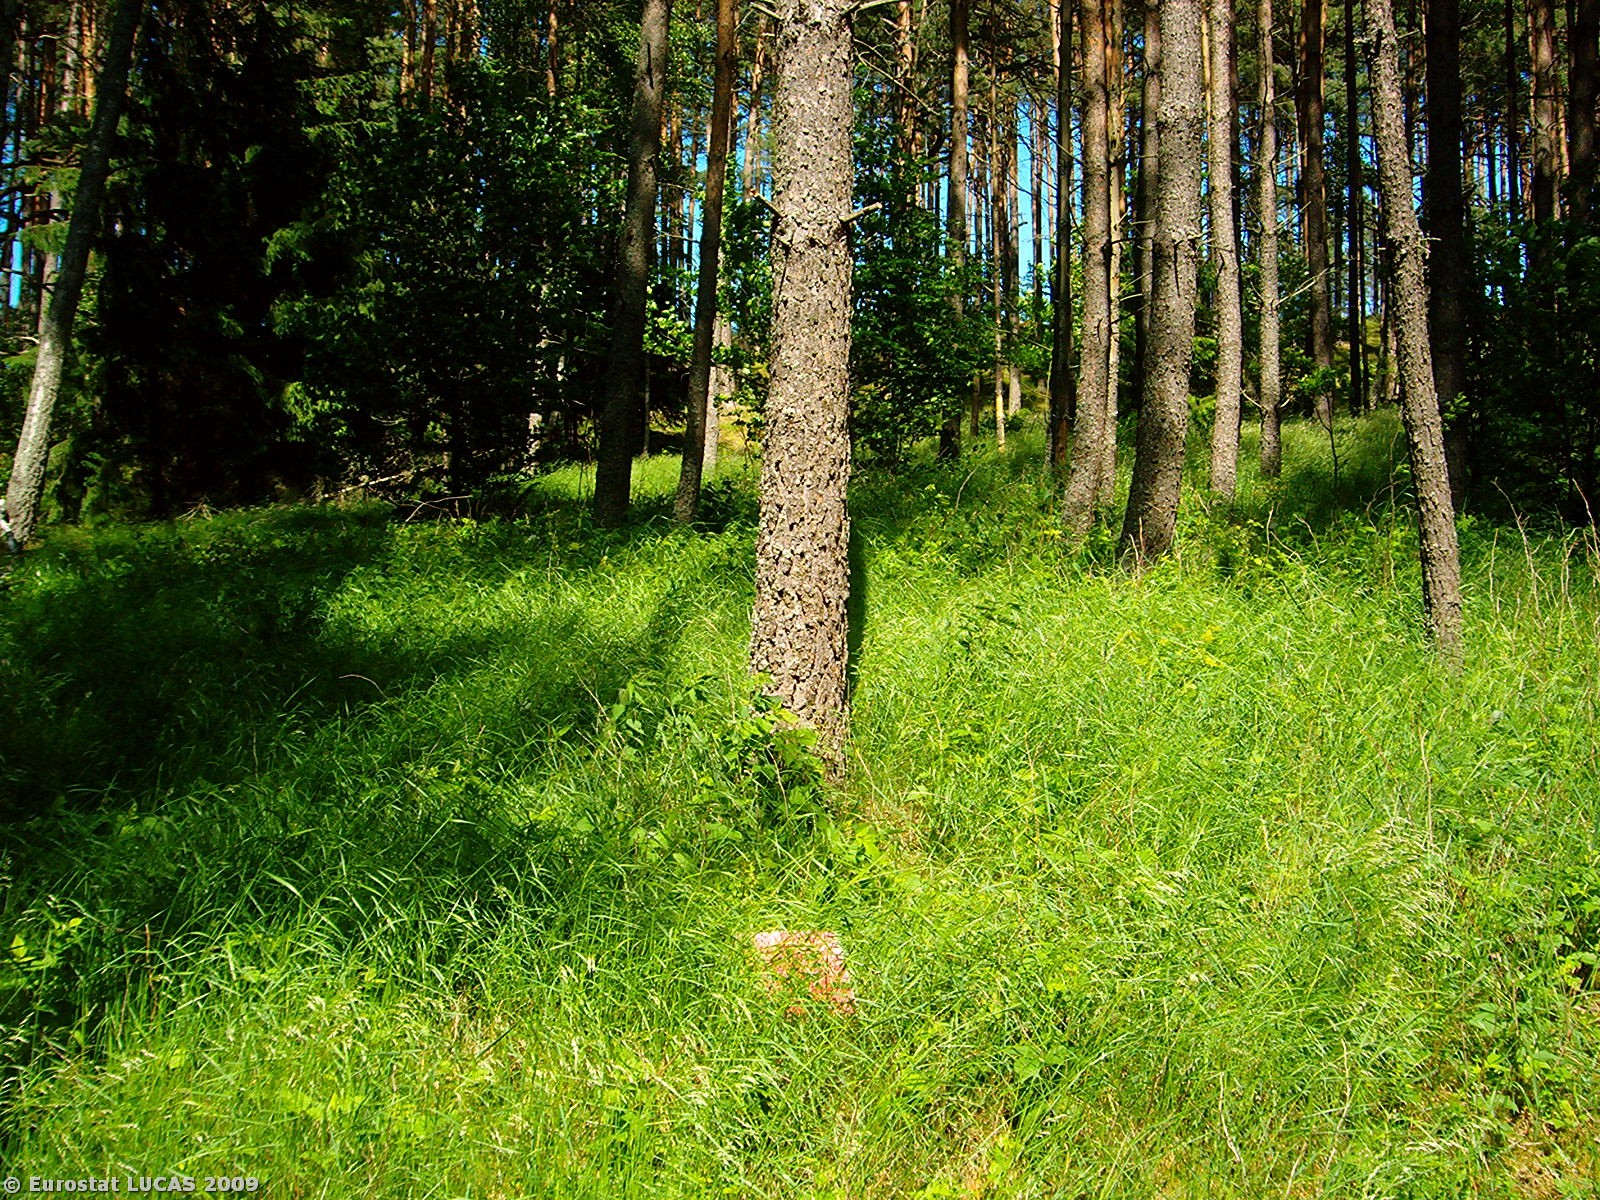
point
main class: Woodland
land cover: Mixed woodland
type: hemiboreal forest and nemoral coniferous forest and mixed broadleaved-coniferous forest
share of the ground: 50 - 75 %
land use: Forestry
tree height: > 5 m
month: June
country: PL
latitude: 53.9447
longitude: 17.2160
